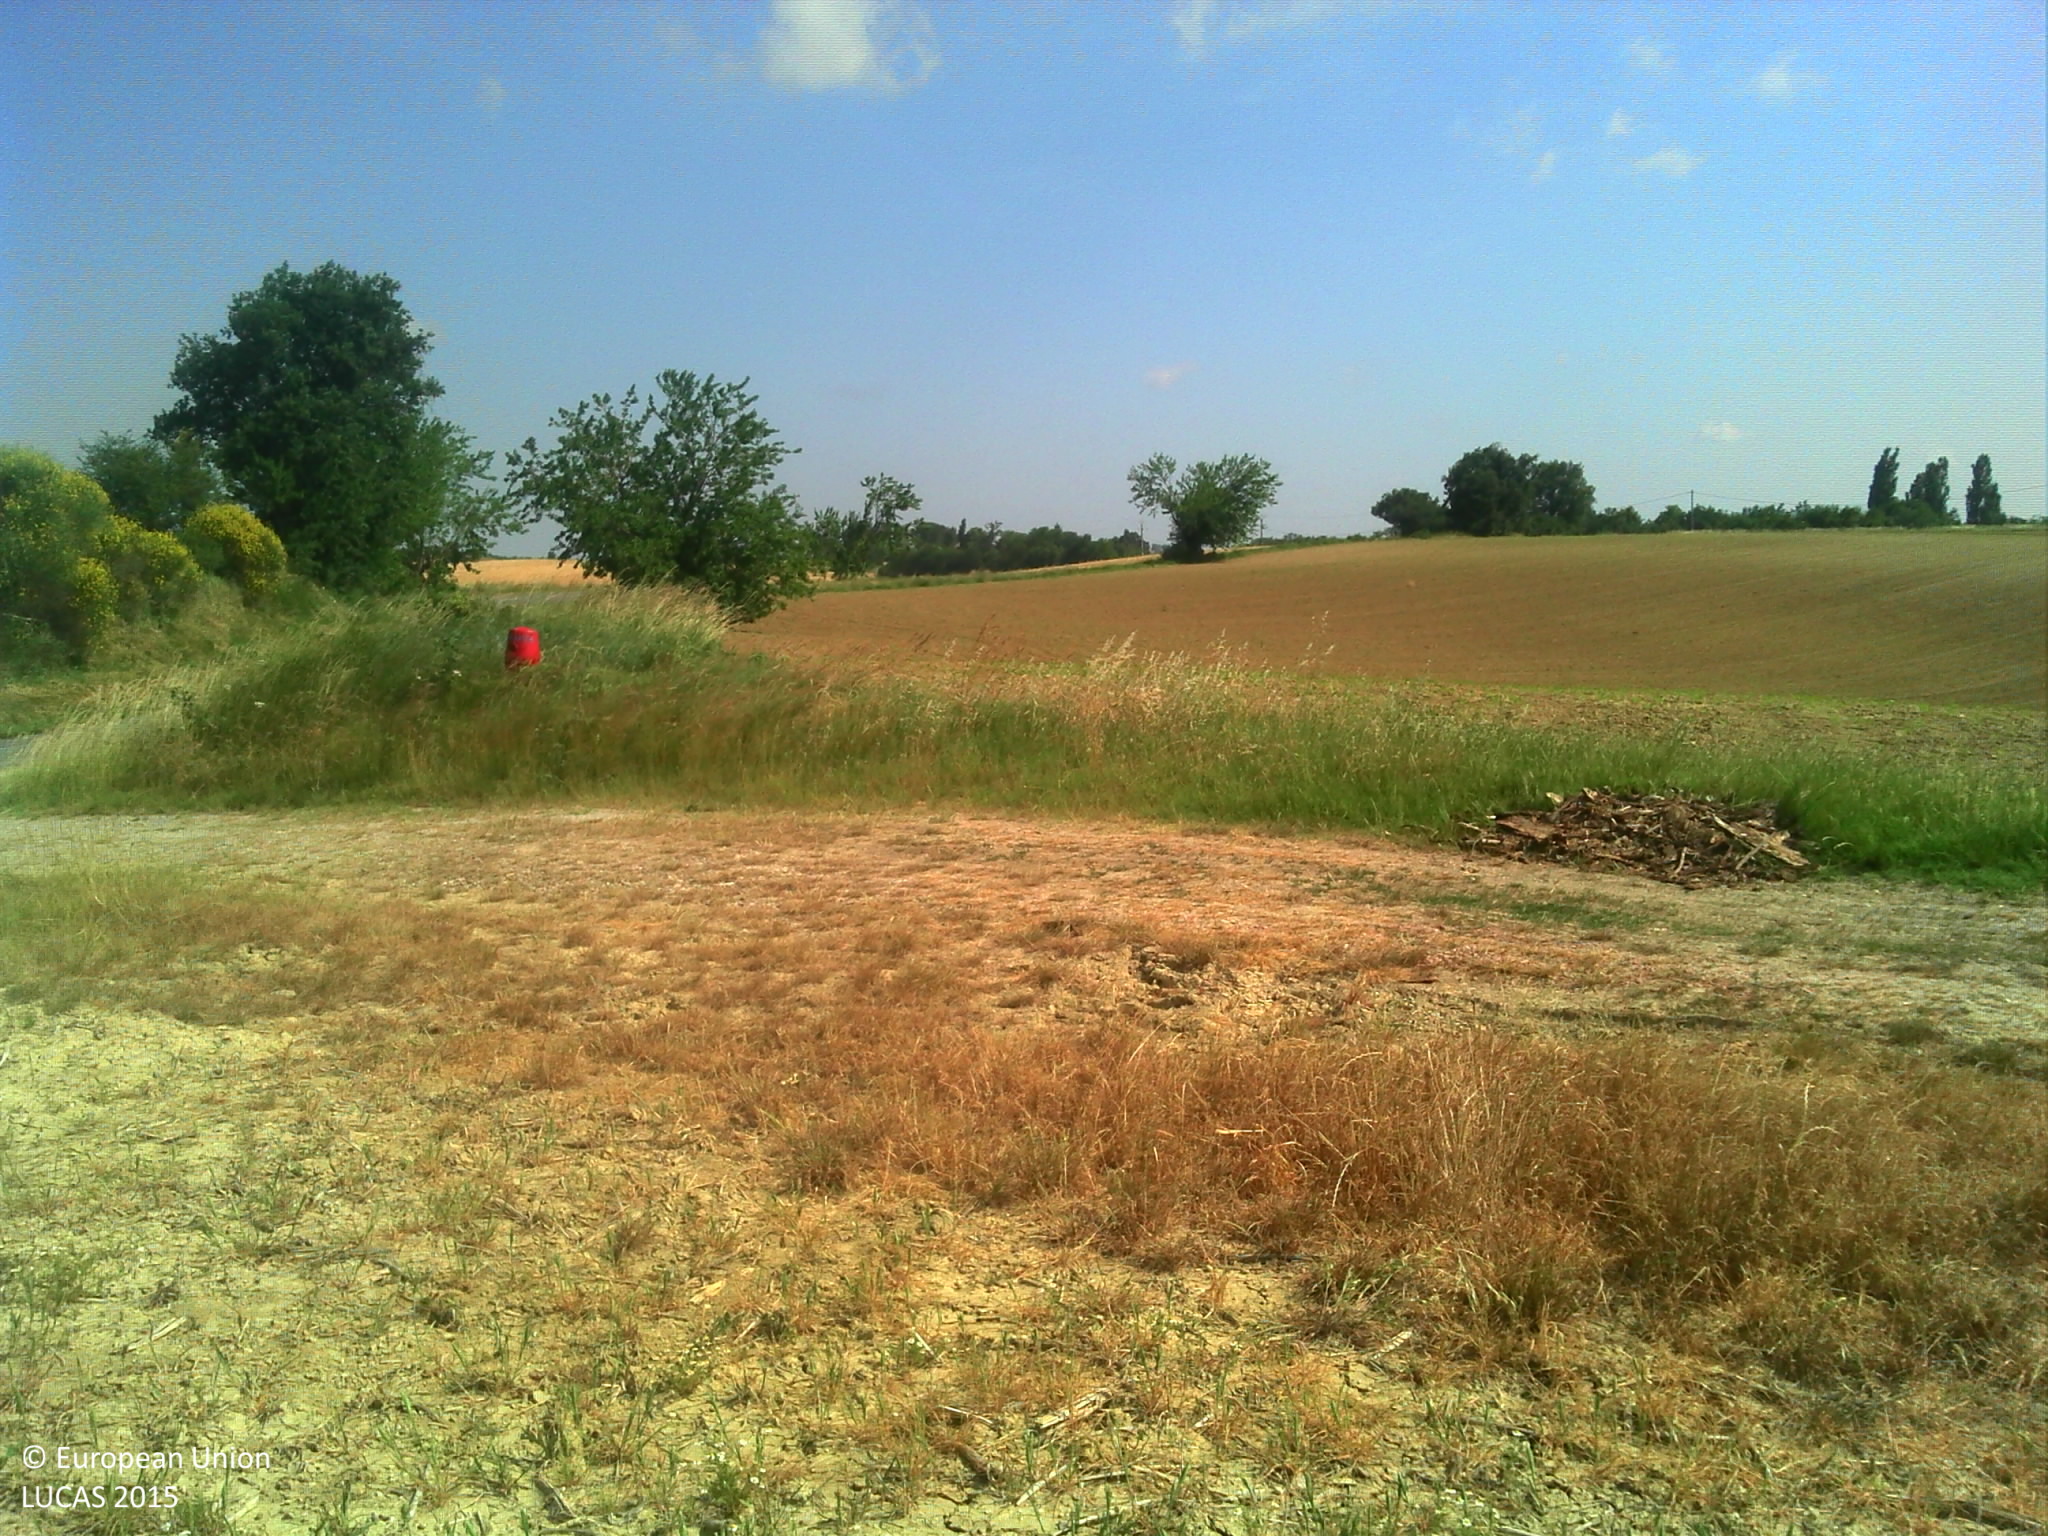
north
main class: Cropland
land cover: Common wheat
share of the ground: 50 - 75 %
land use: Agriculture (excluding fallow land and kitchen gardens)
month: June
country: FR
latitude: 43.8728
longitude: 1.7020
